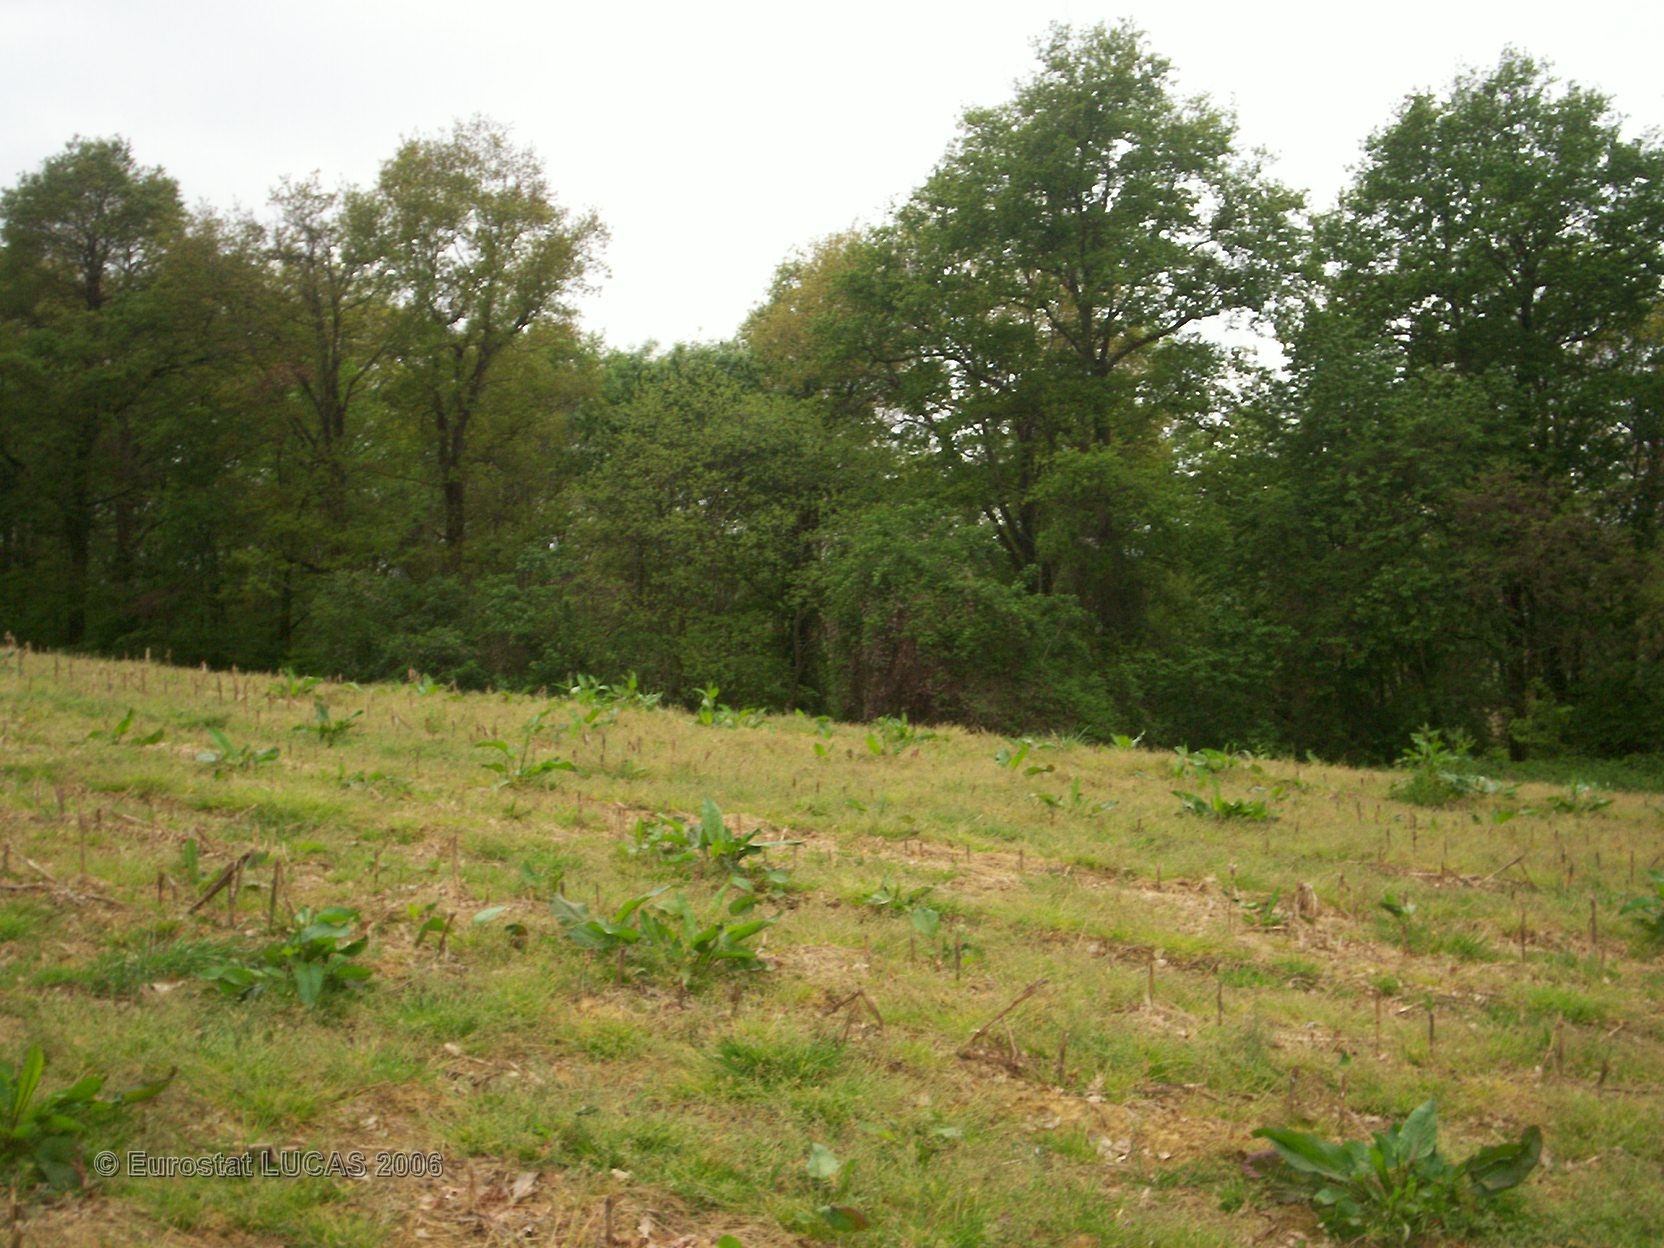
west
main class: Grassland
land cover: Grassland without tree/shrub cover
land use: Agriculture (excluding fallow land and kitchen gardens)
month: April
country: FR
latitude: 43.2622
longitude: 0.3279
